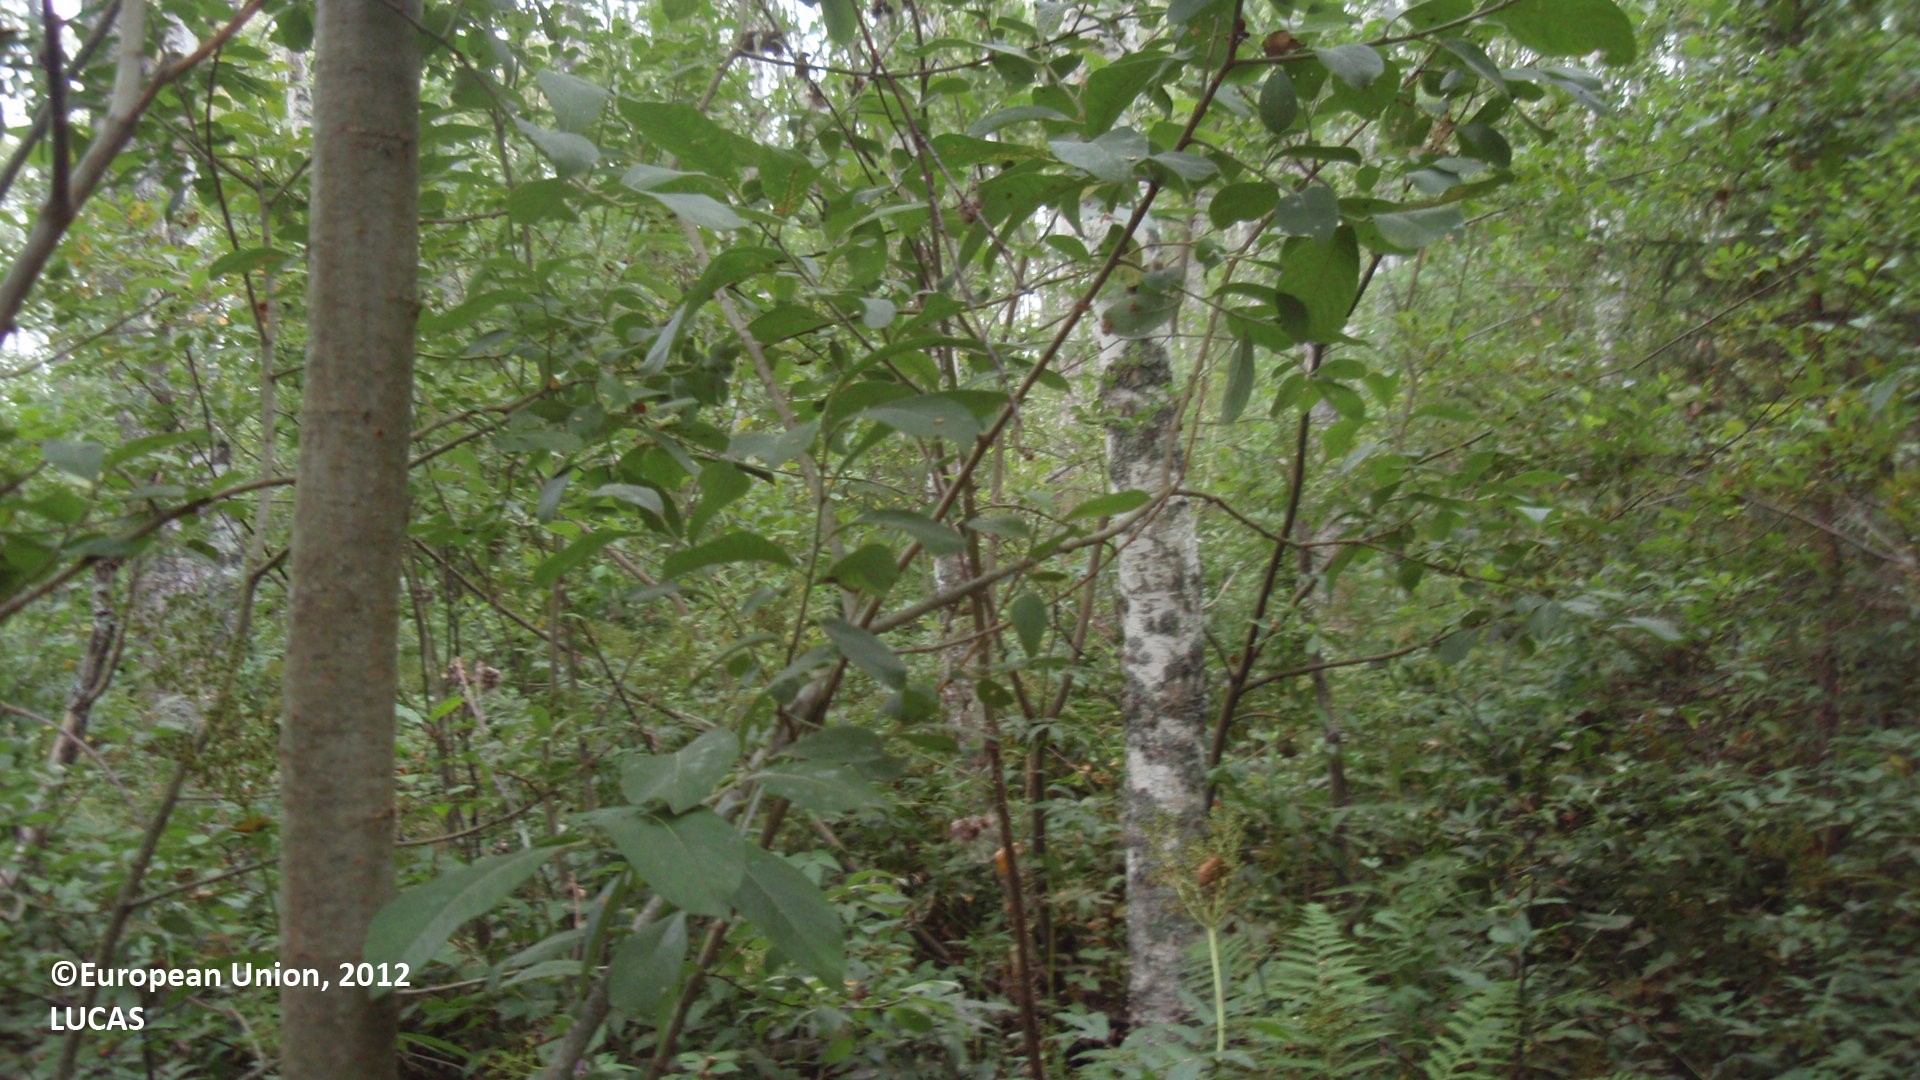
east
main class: Woodland
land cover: Broadleaved woodland
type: non-riverine alder, birch or aspen forest
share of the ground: > 75 %
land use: Forestry
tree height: > 5 m
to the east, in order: Broadleaved woodland; Paved roads, cycling and walking lanes; Grassland with sparse tree/shrub cover; Artificial constructions in urban areas; Broadleaved woodland; Inland water bodies
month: August
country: FI
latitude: 61.0495
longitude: 26.6188
